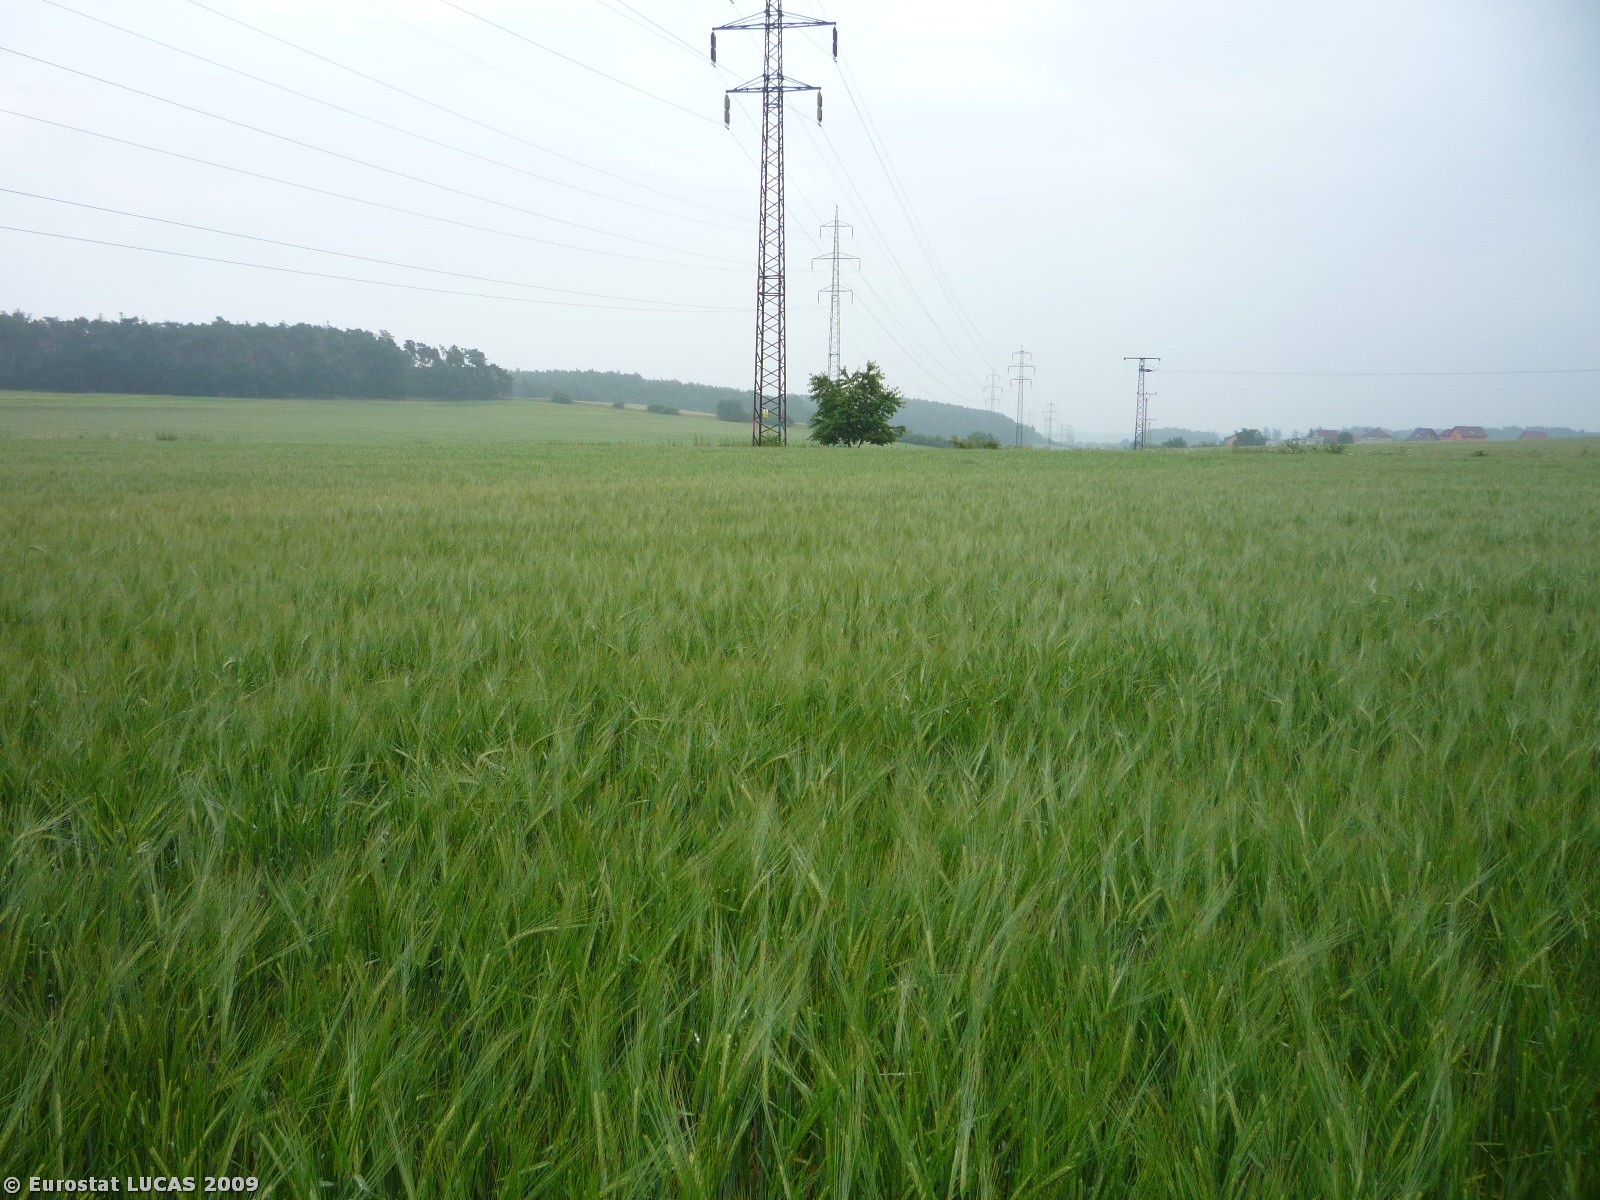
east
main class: Cropland
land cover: Barley
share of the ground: > 75 %
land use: Agriculture (excluding fallow land and kitchen gardens)
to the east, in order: Barley; Tracks; Grassland with sparse tree/shrub cover; Barley; Electric lines; Barley; Electric lines; Barley
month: June
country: CZ
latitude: 50.1145
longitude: 14.9111
